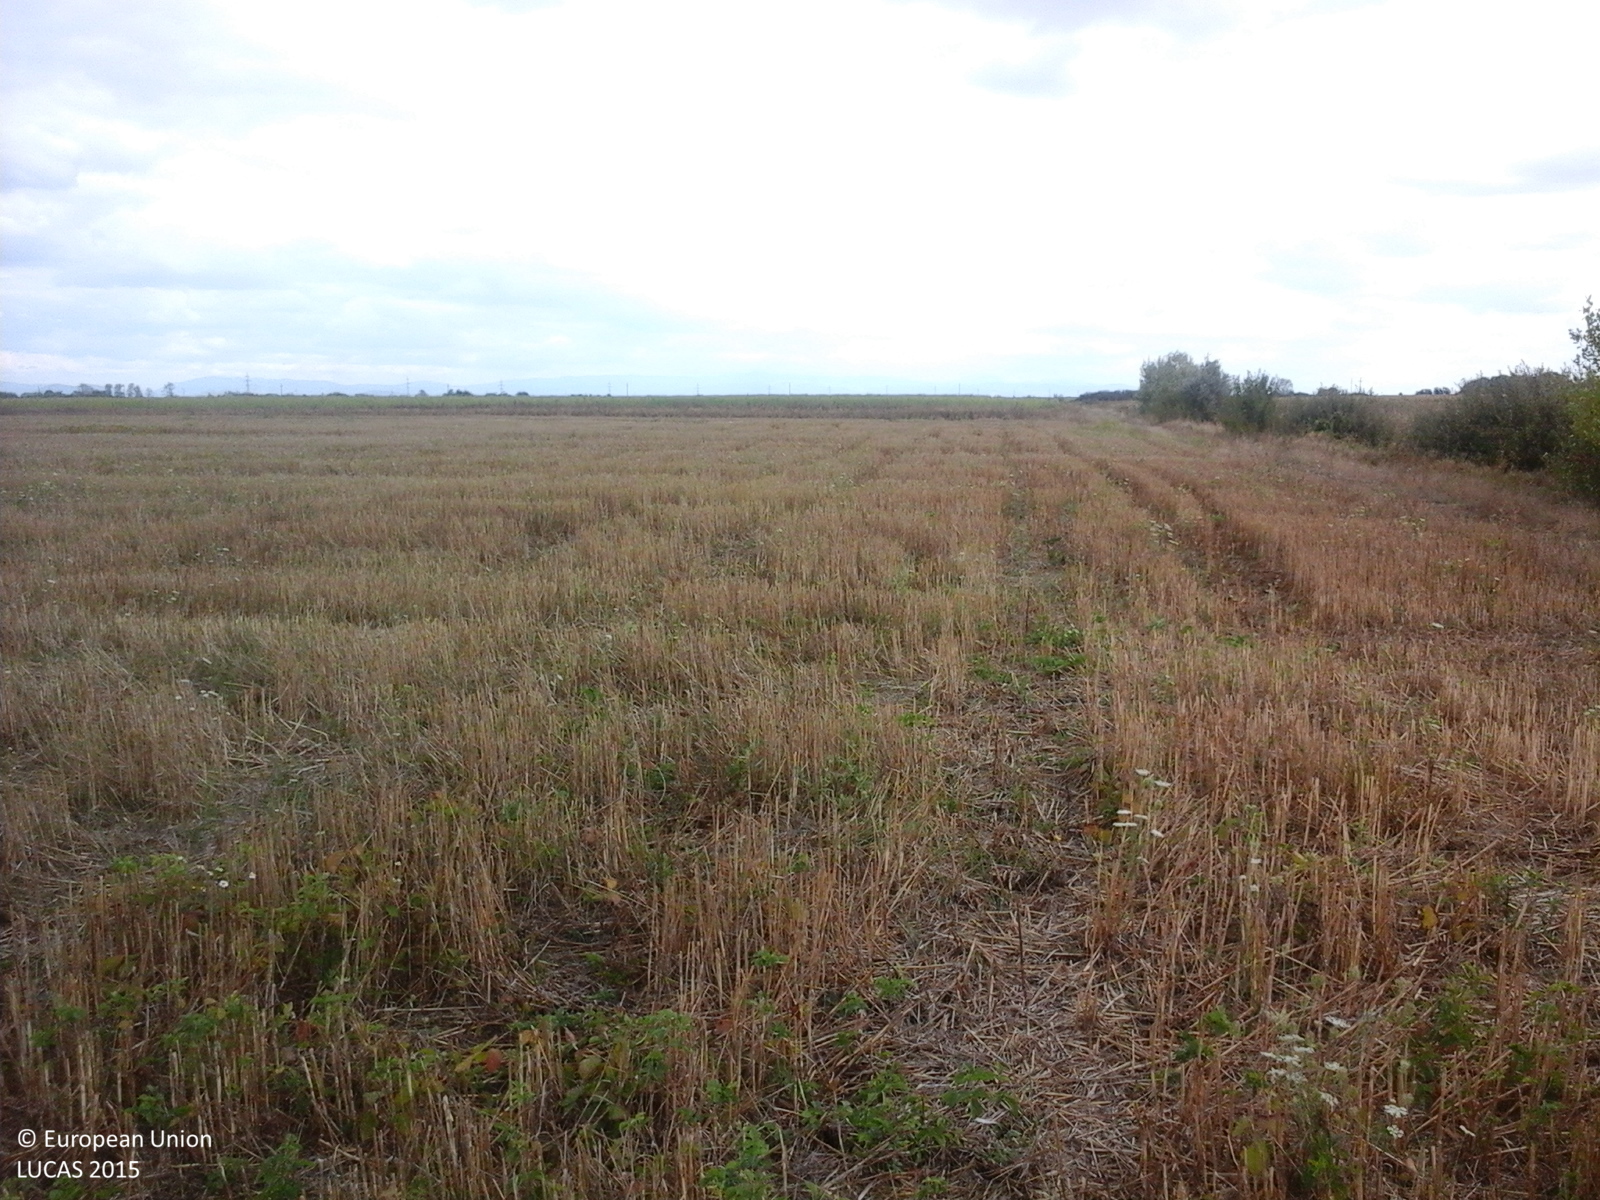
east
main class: Cropland
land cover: Durum wheat
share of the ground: > 75 %
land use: Agriculture (excluding fallow land and kitchen gardens)
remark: Harvested field
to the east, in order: Durum wheat; Spontaneously vegetated surfaces; Grassland without tree/shrub cover; Maize; Spontaneously vegetated surfaces
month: September
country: RO
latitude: 47.7521
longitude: 22.9104
